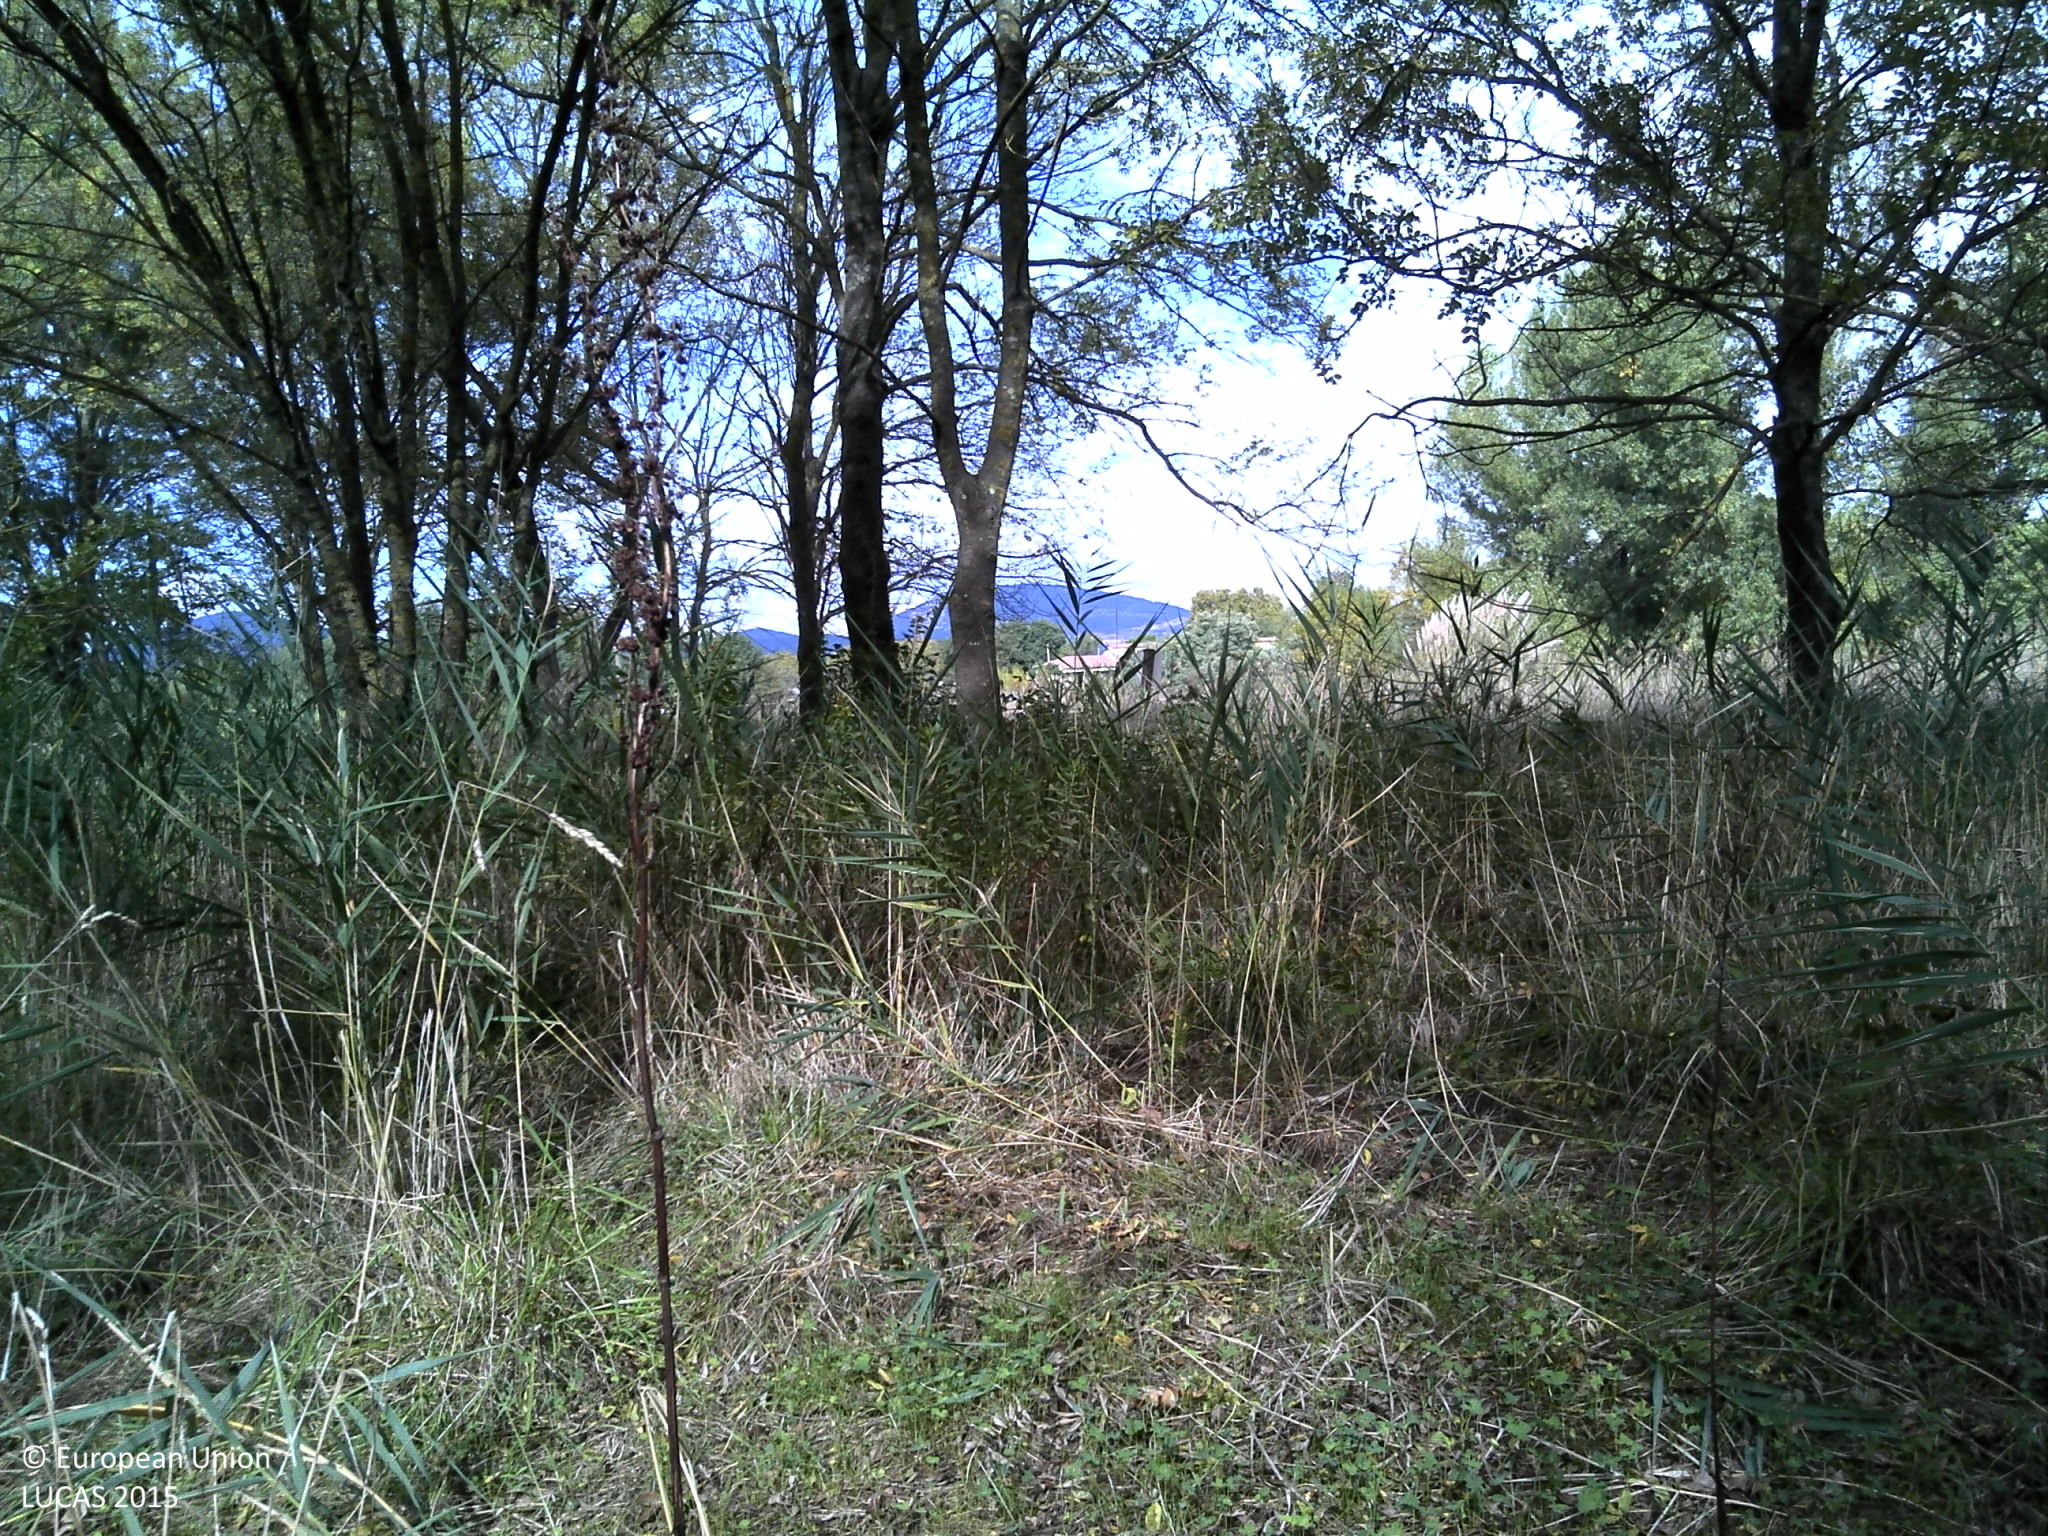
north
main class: Woodland
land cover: Broadleaved woodland
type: thermophilous deciduous forest
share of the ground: > 75 %
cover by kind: broadleaved forest trees 70 %, herbaceous plants 20 %, unconsolidated bare surface 10 %
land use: Abandoned areas
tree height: > 5 m
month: October
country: FR
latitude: 43.2646
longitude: 6.5717
